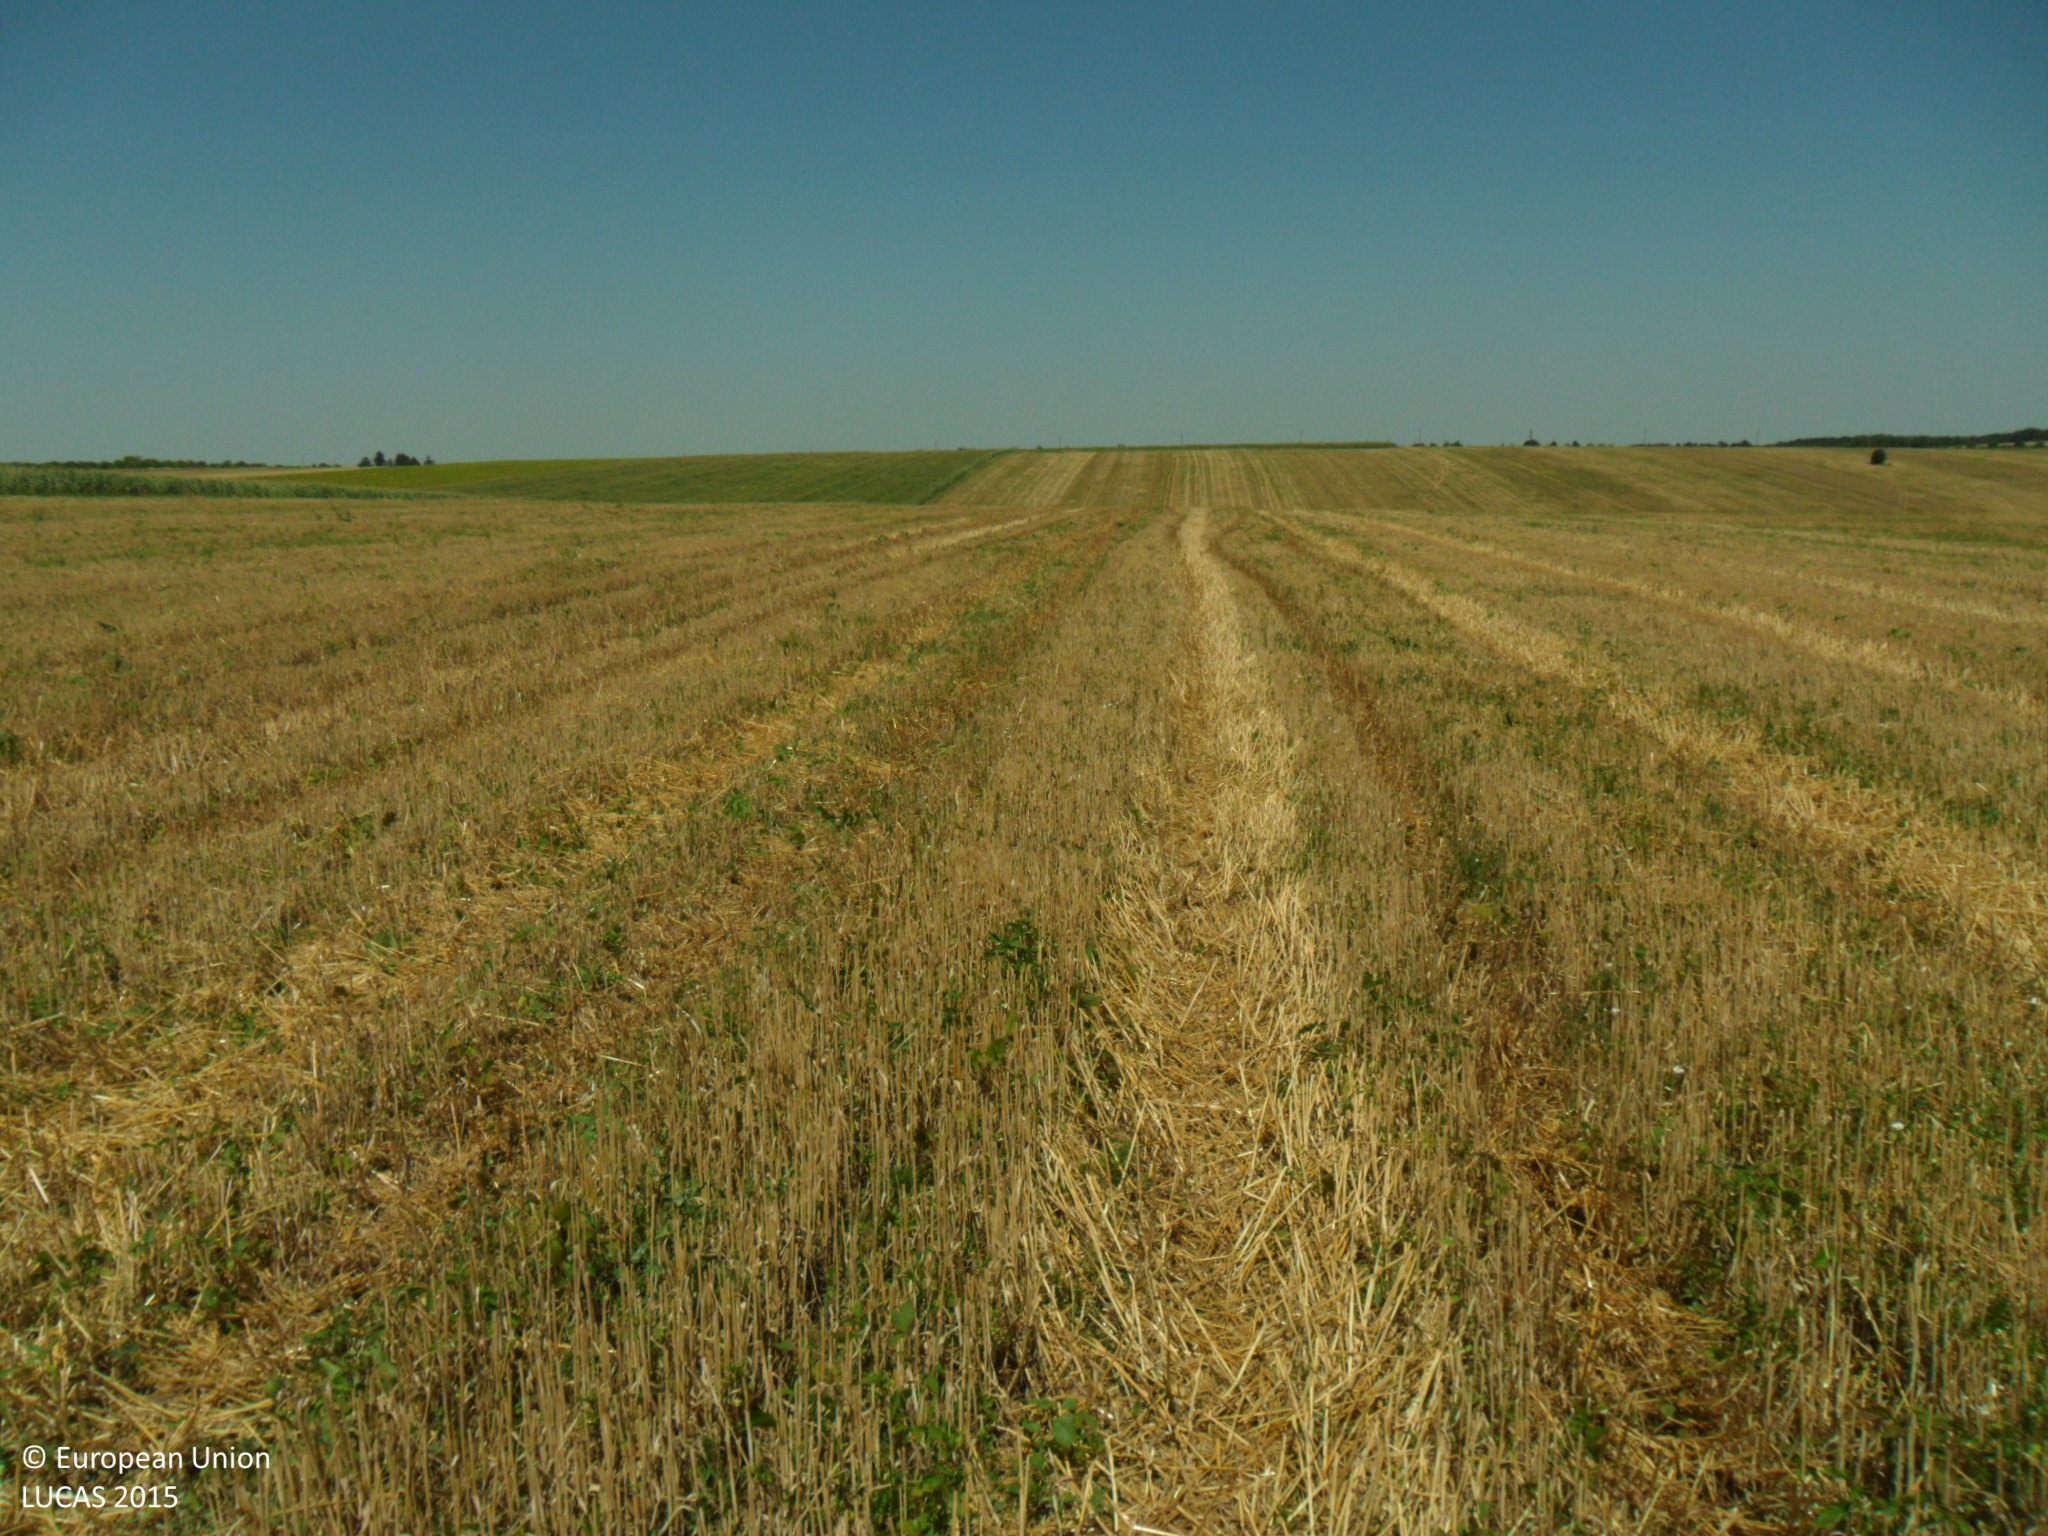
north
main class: Cropland
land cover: Common wheat
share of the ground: 50 - 75 %
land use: Agriculture (excluding fallow land and kitchen gardens)
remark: Harvested field
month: July
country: BG
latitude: 43.8025
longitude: 26.4265
